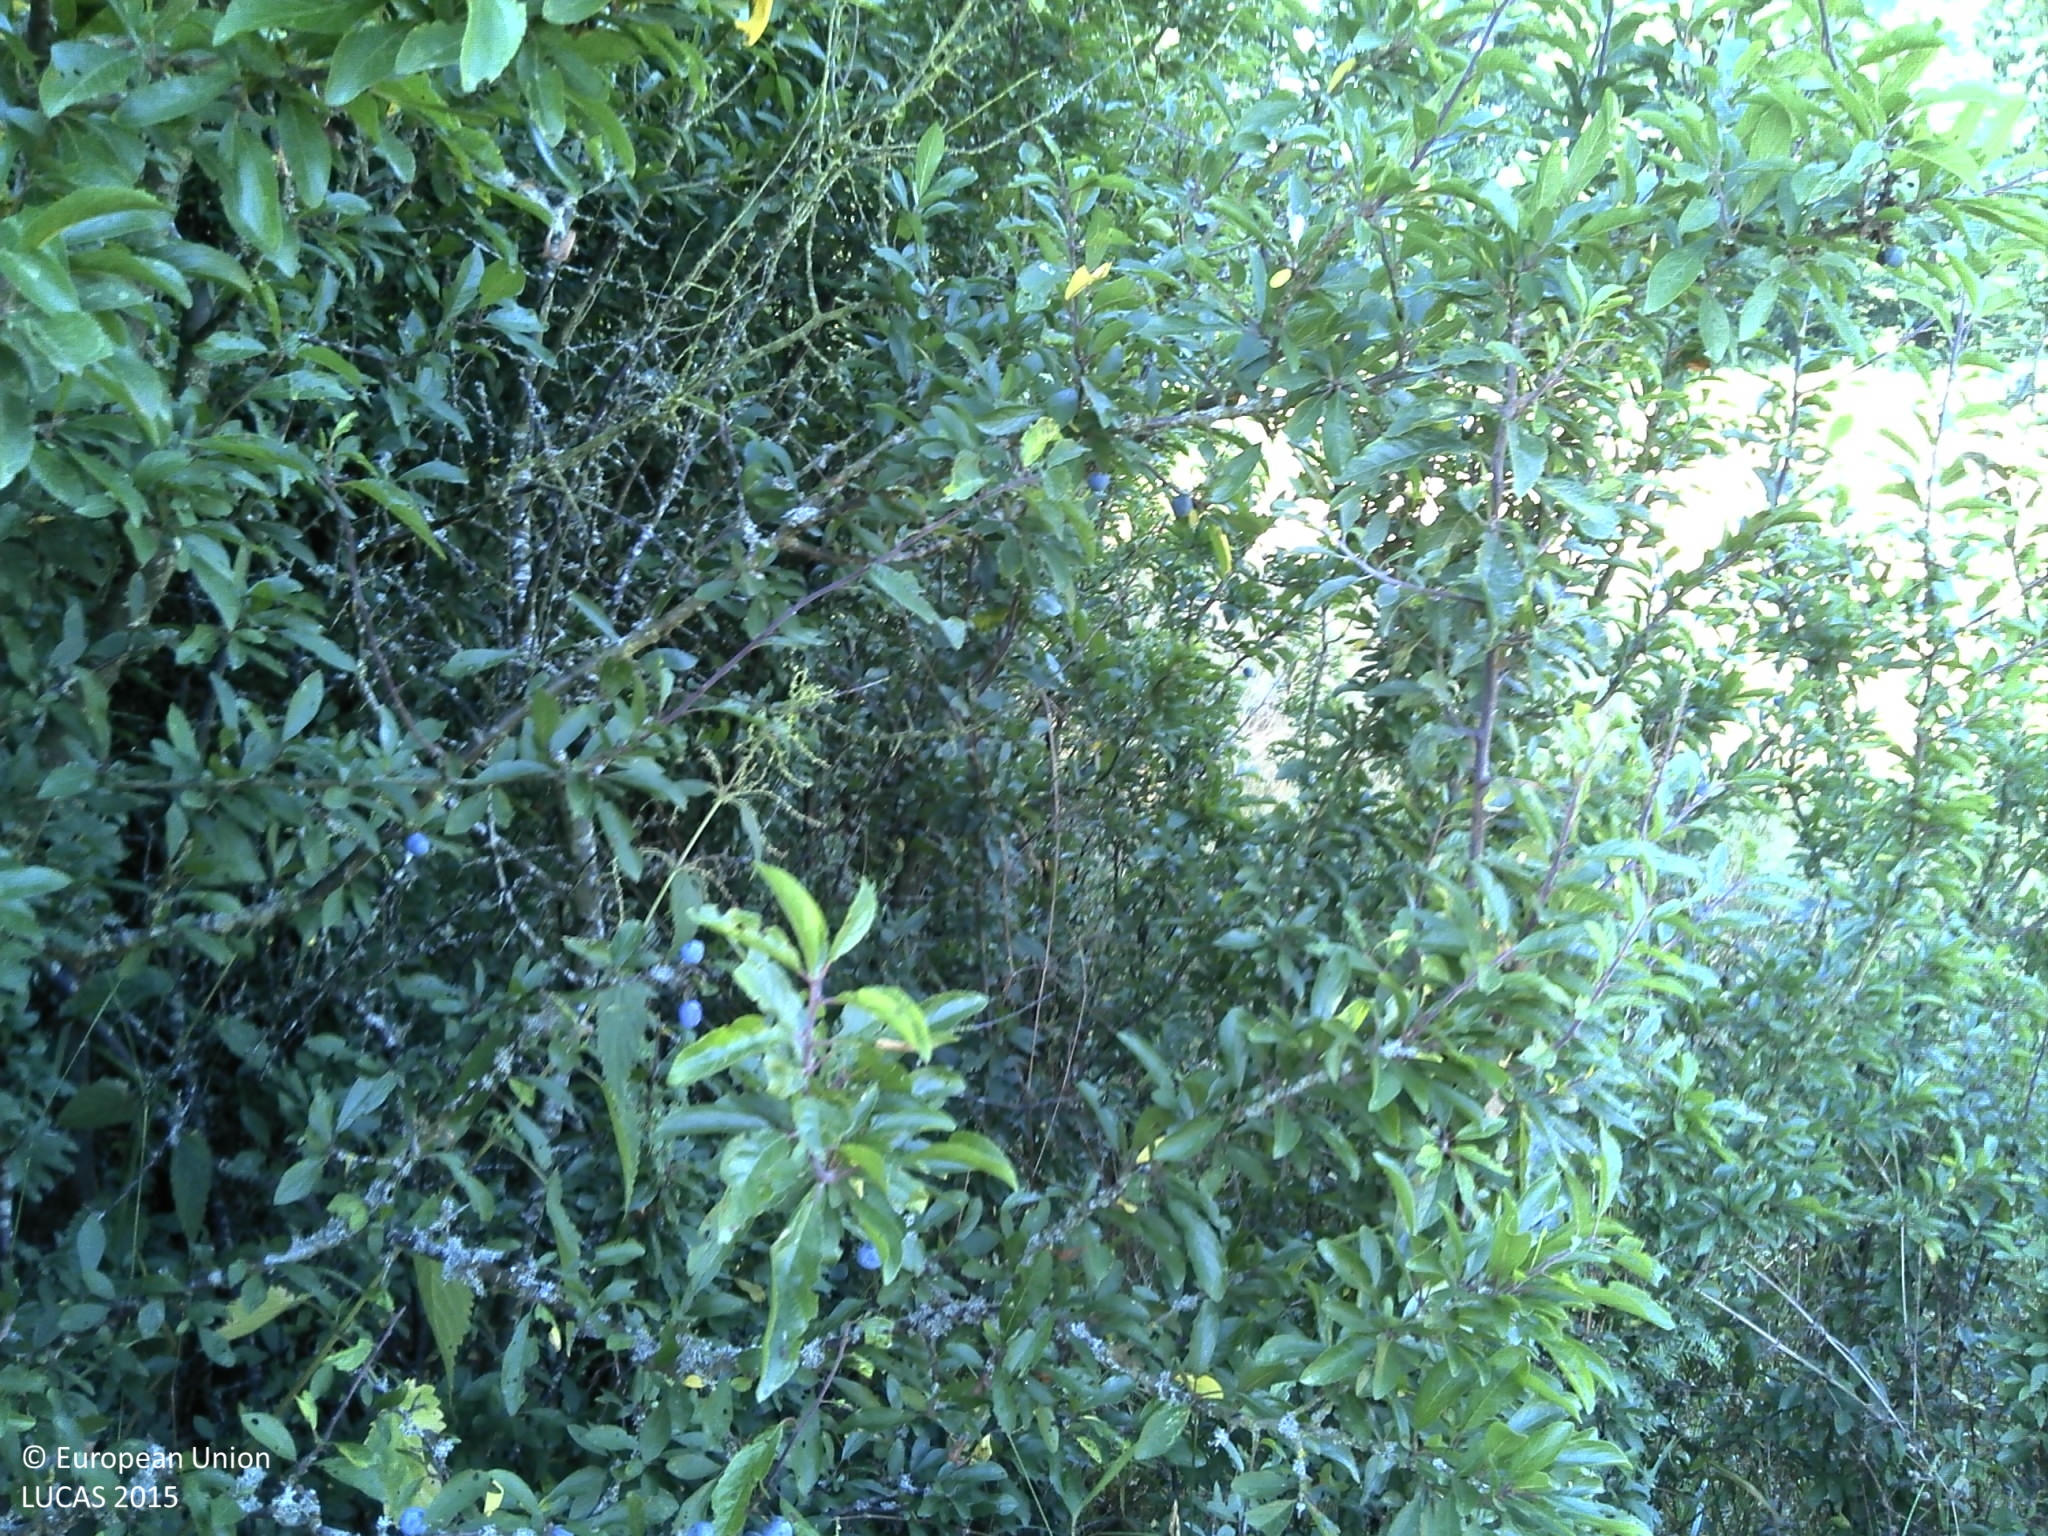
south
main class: Grassland
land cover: Spontaneously vegetated surfaces
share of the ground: > 75 %
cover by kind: herbaceous plants 100 %
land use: Agriculture (excluding fallow land and kitchen gardens)
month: July
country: FR
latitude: 48.3395
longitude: 6.2364
